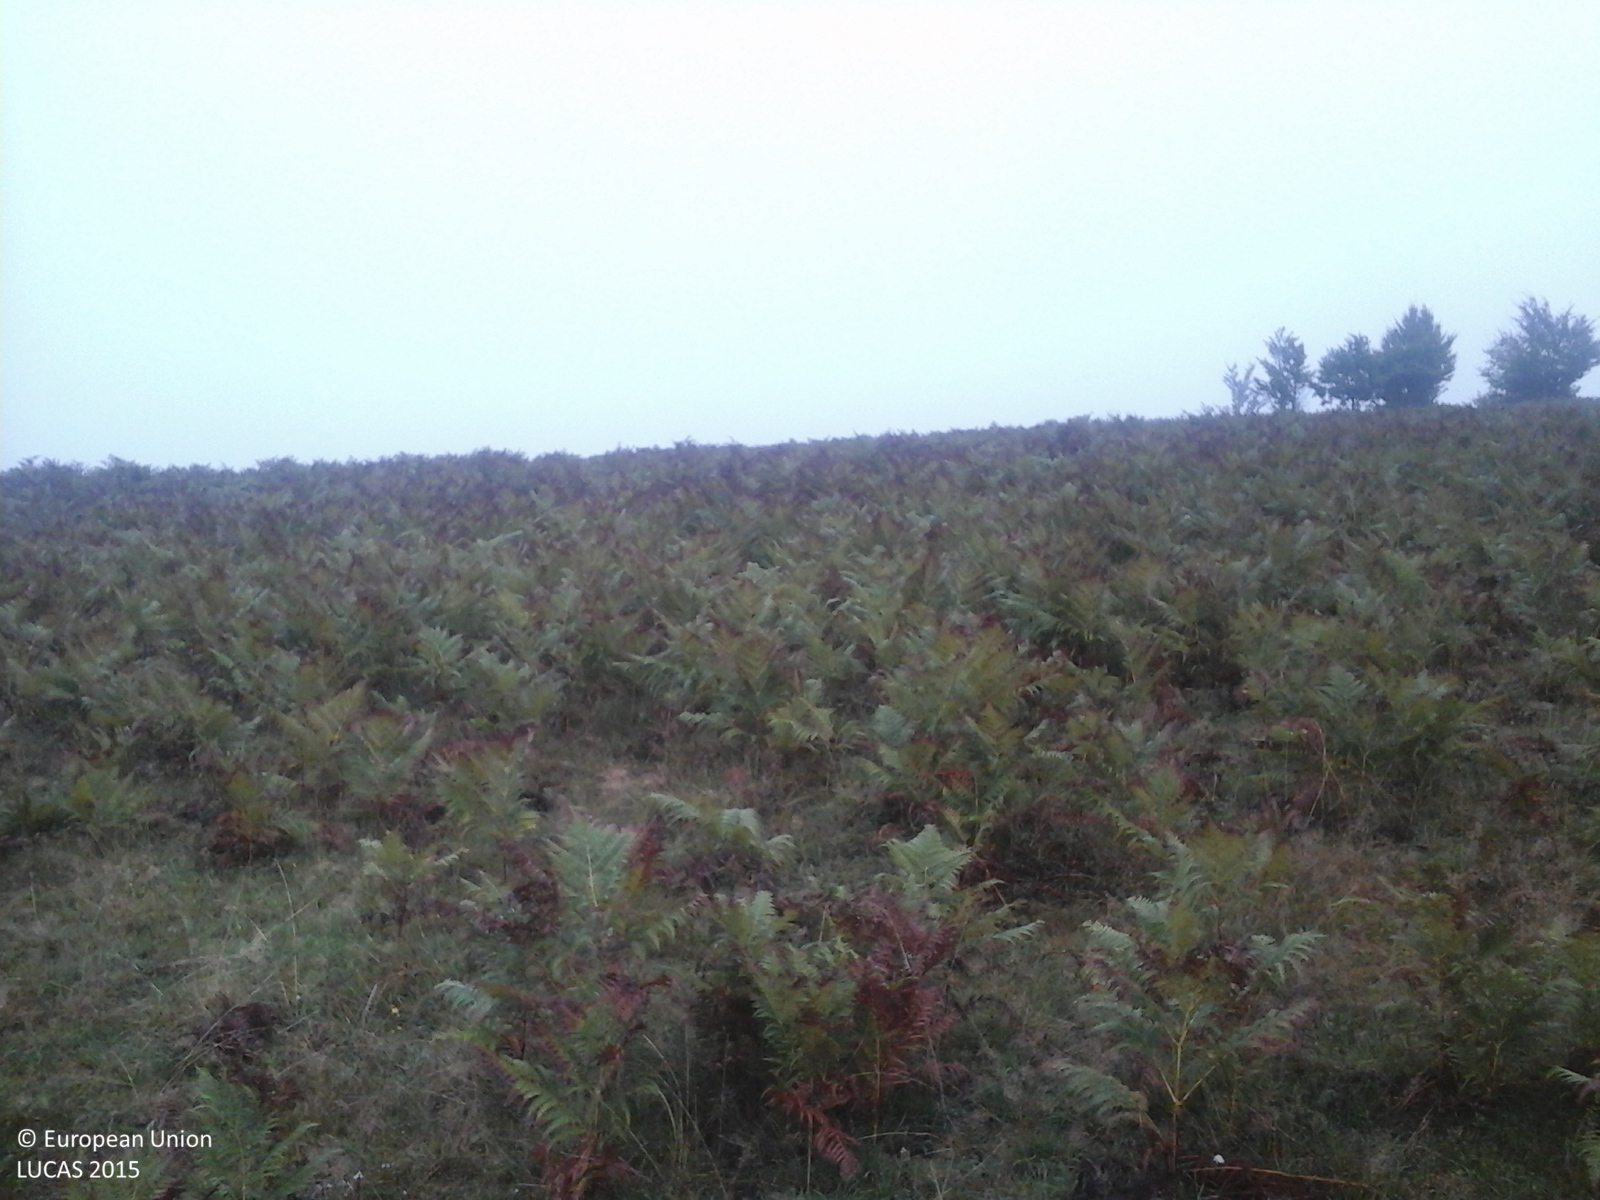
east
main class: Grassland
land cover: Spontaneously vegetated surfaces
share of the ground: > 75 %
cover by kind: herbaceous plants 100 %
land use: Agriculture (excluding fallow land and kitchen gardens)
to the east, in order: Spontaneously vegetated surfaces; Tracks; Spontaneously vegetated surfaces; Shrubland with sparse tree cover
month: September
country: RO
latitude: 46.9833
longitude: 22.4778
